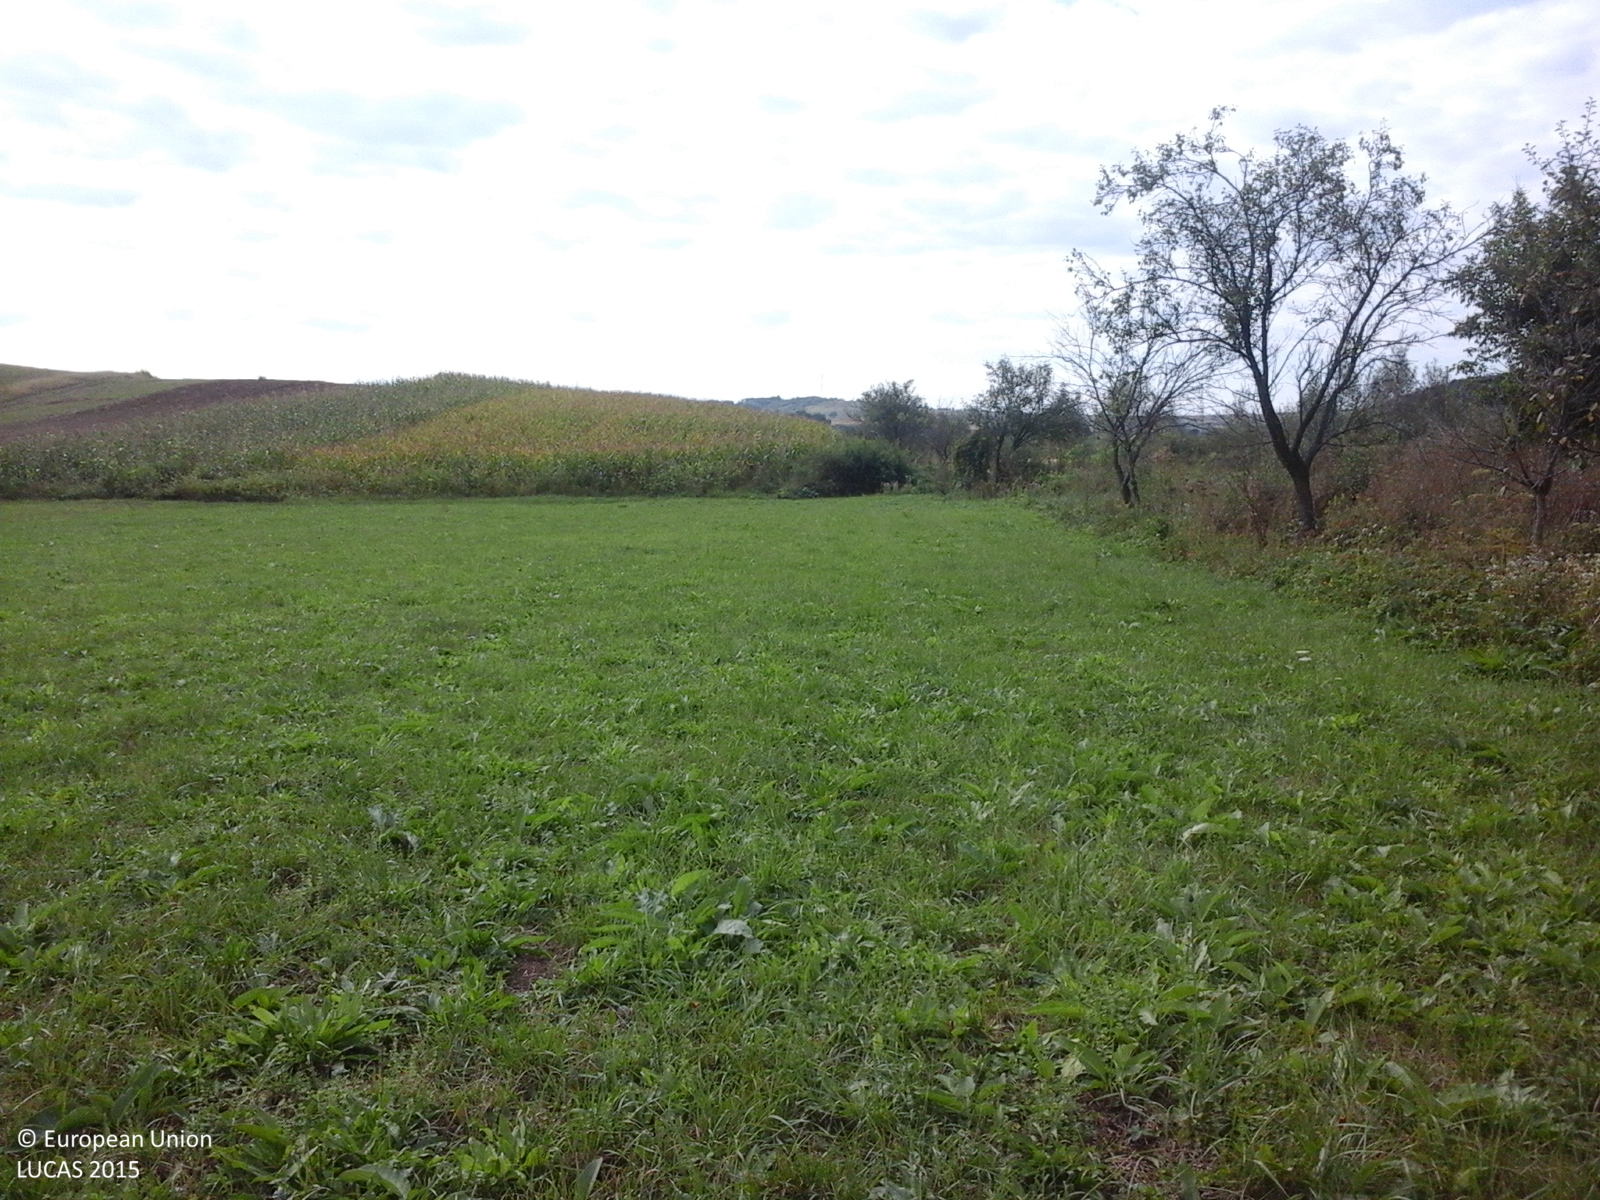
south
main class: Grassland
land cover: Grassland without tree/shrub cover
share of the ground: > 75 %
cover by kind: herbaceous plants 100 %
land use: Agriculture (excluding fallow land and kitchen gardens)
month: September
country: RO
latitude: 47.3927
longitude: 23.1699
